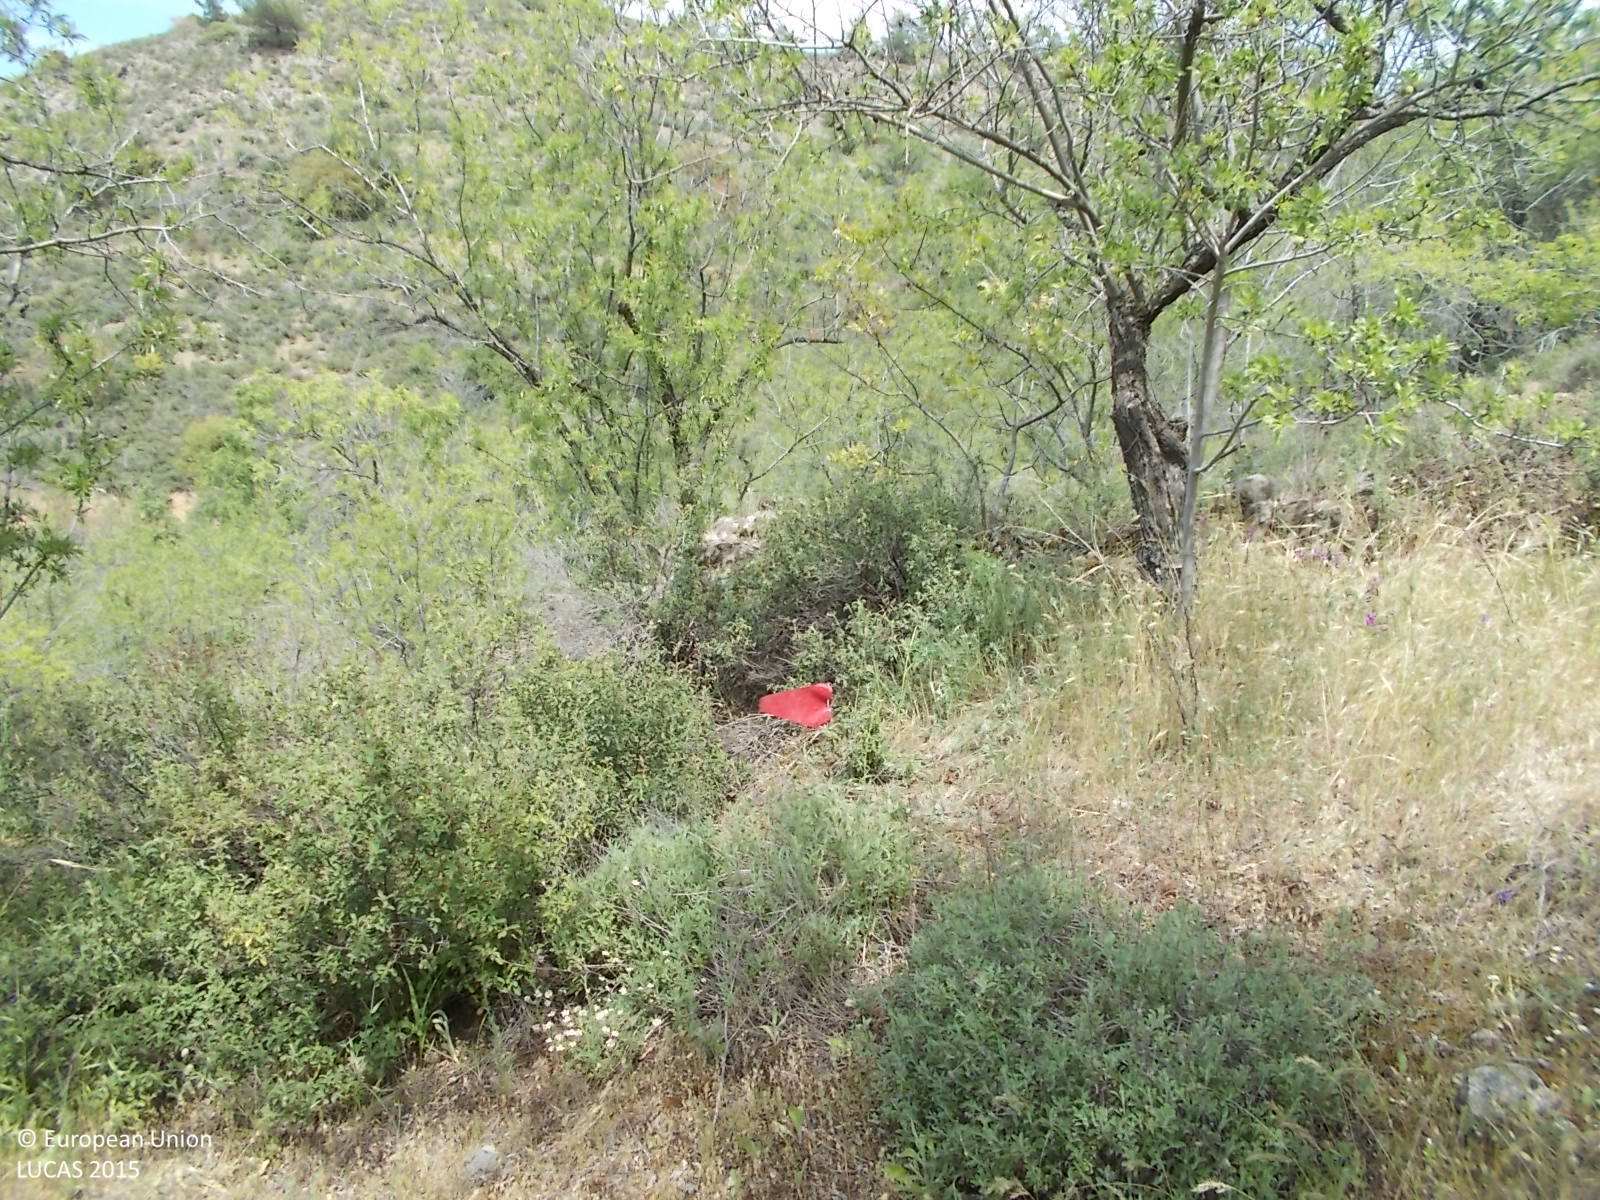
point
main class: Cropland
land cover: Nuts trees
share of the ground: > 75 %
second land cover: Grassland without tree/shrub cover
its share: > 75 %
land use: Abandoned areas
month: May
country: CY
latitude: 34.9449
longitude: 33.0700
